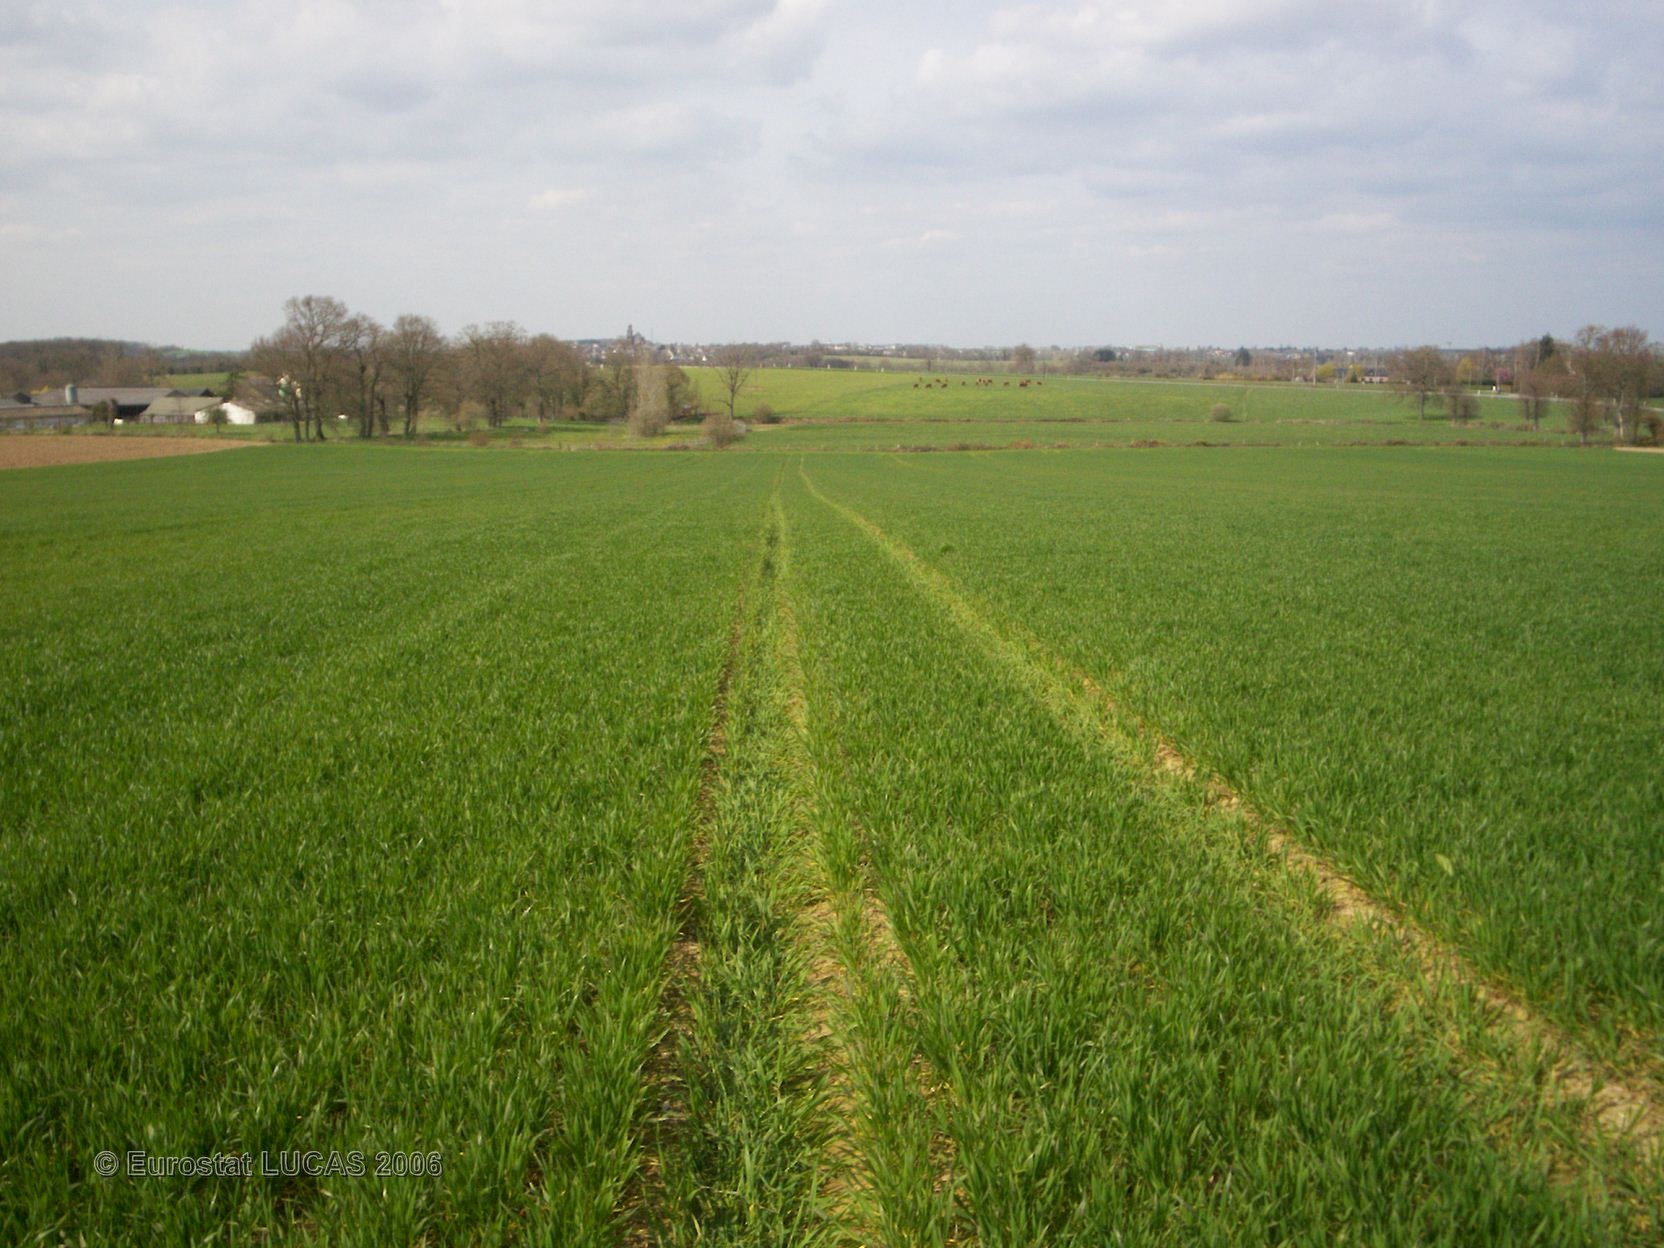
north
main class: Cropland
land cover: Common wheat
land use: Agriculture (excluding fallow land and kitchen gardens)
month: April
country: FR
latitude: 47.9568
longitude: -1.5760
